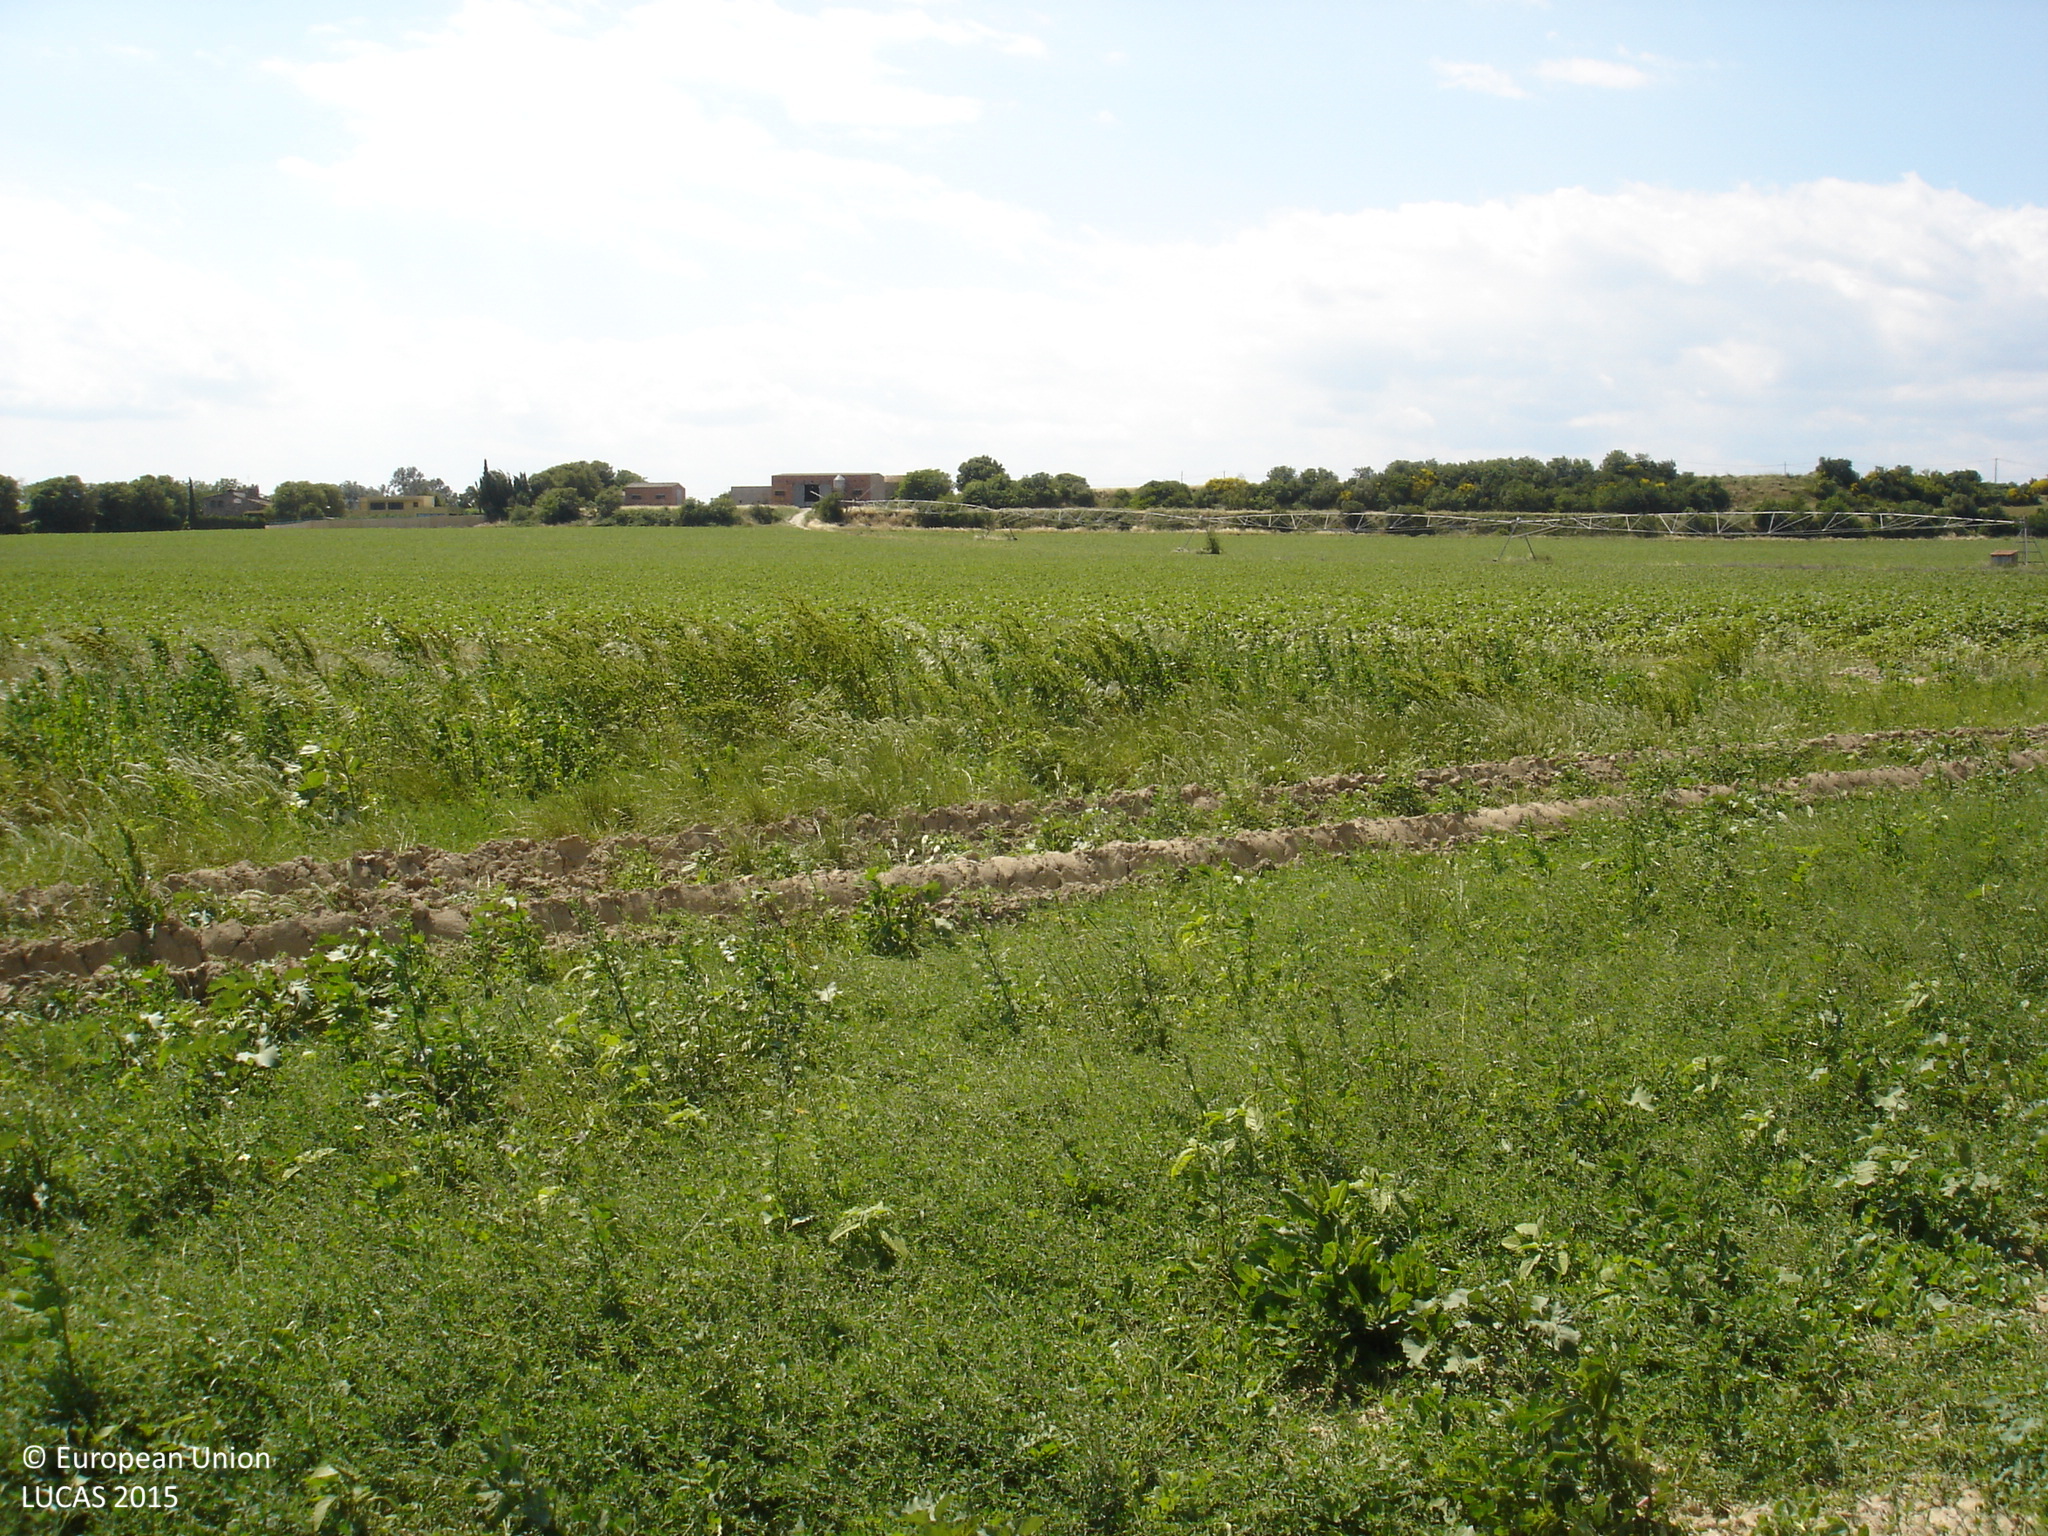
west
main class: Grassland
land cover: Grassland without tree/shrub cover
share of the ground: 10 - 25 %
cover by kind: consolidated bare surface 90 %, herbaceous plants 10 %
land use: Agriculture (excluding fallow land and kitchen gardens)
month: May
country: ES
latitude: 42.2124
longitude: 3.0010
